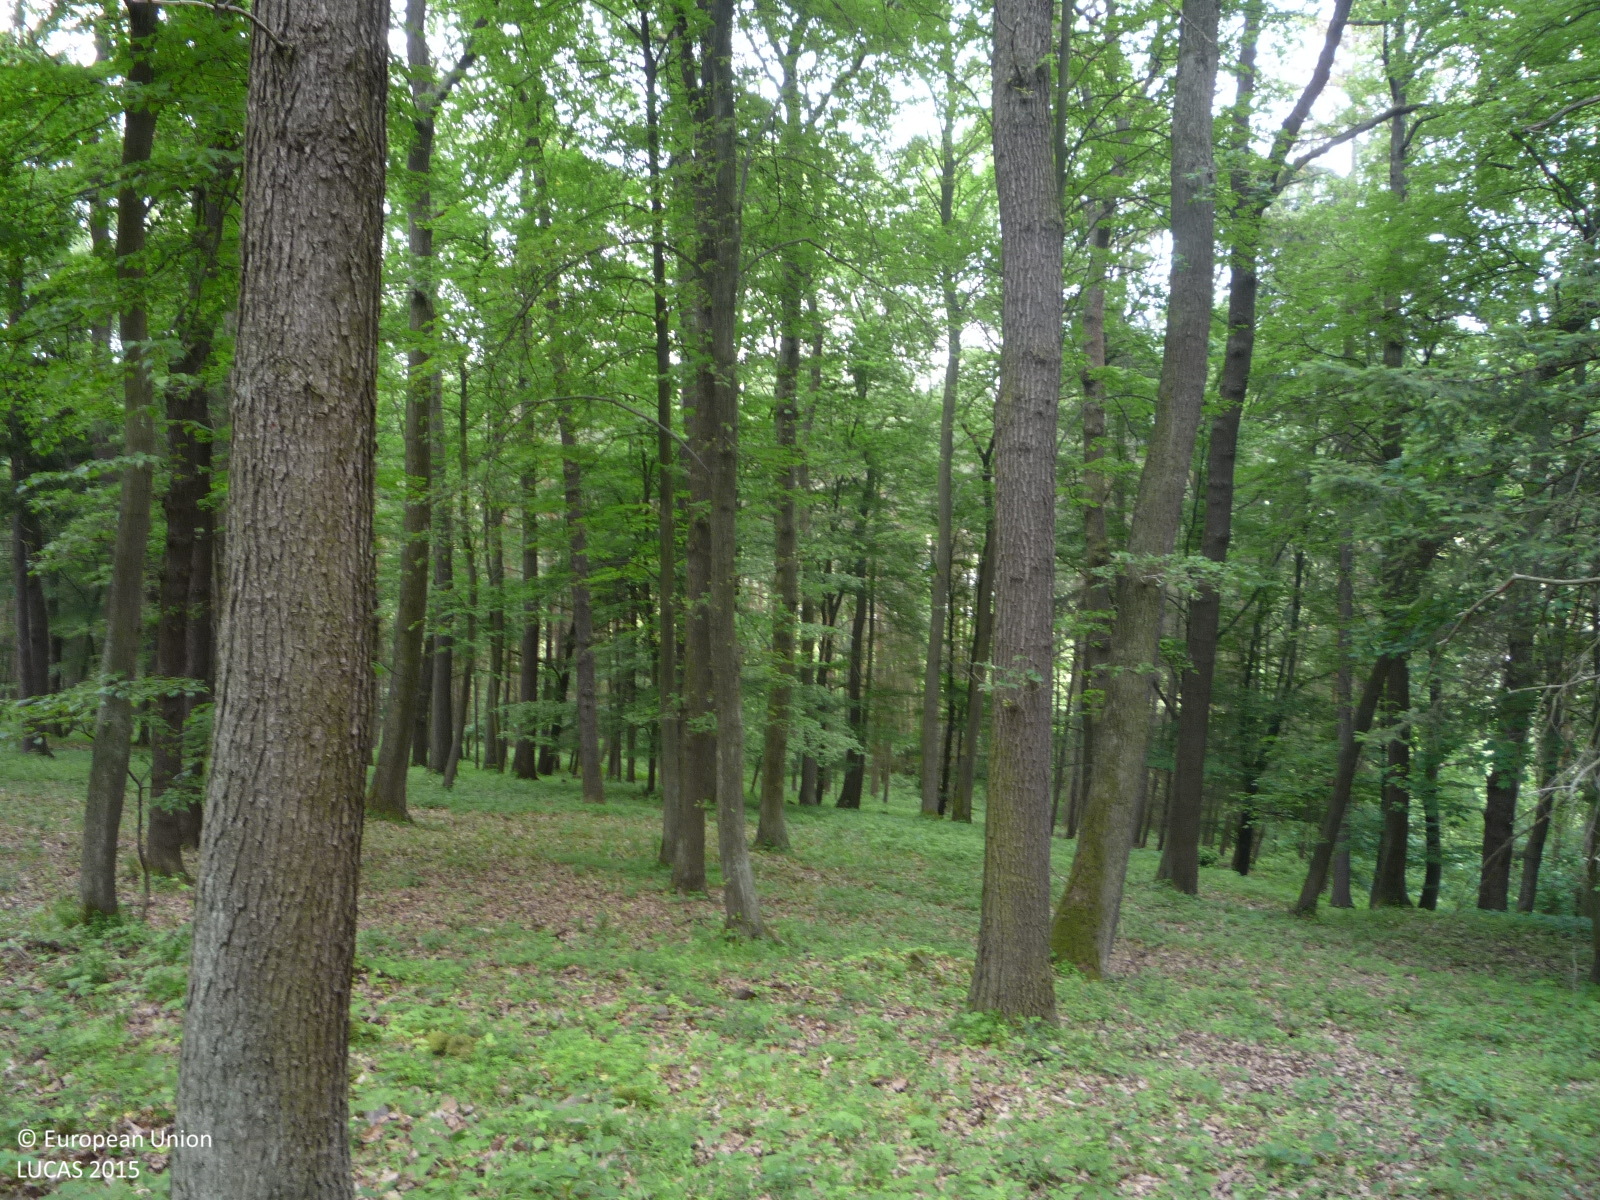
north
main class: Woodland
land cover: Broadleaved woodland
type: mesophytic deciduous forest
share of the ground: > 75 %
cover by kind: broadleaved forest trees 90 %, coniferous forest trees 5 %, herbaceous plants 5 %
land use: Forestry
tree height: > 5 m
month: June
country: CZ
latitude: 50.5932
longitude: 14.1968
